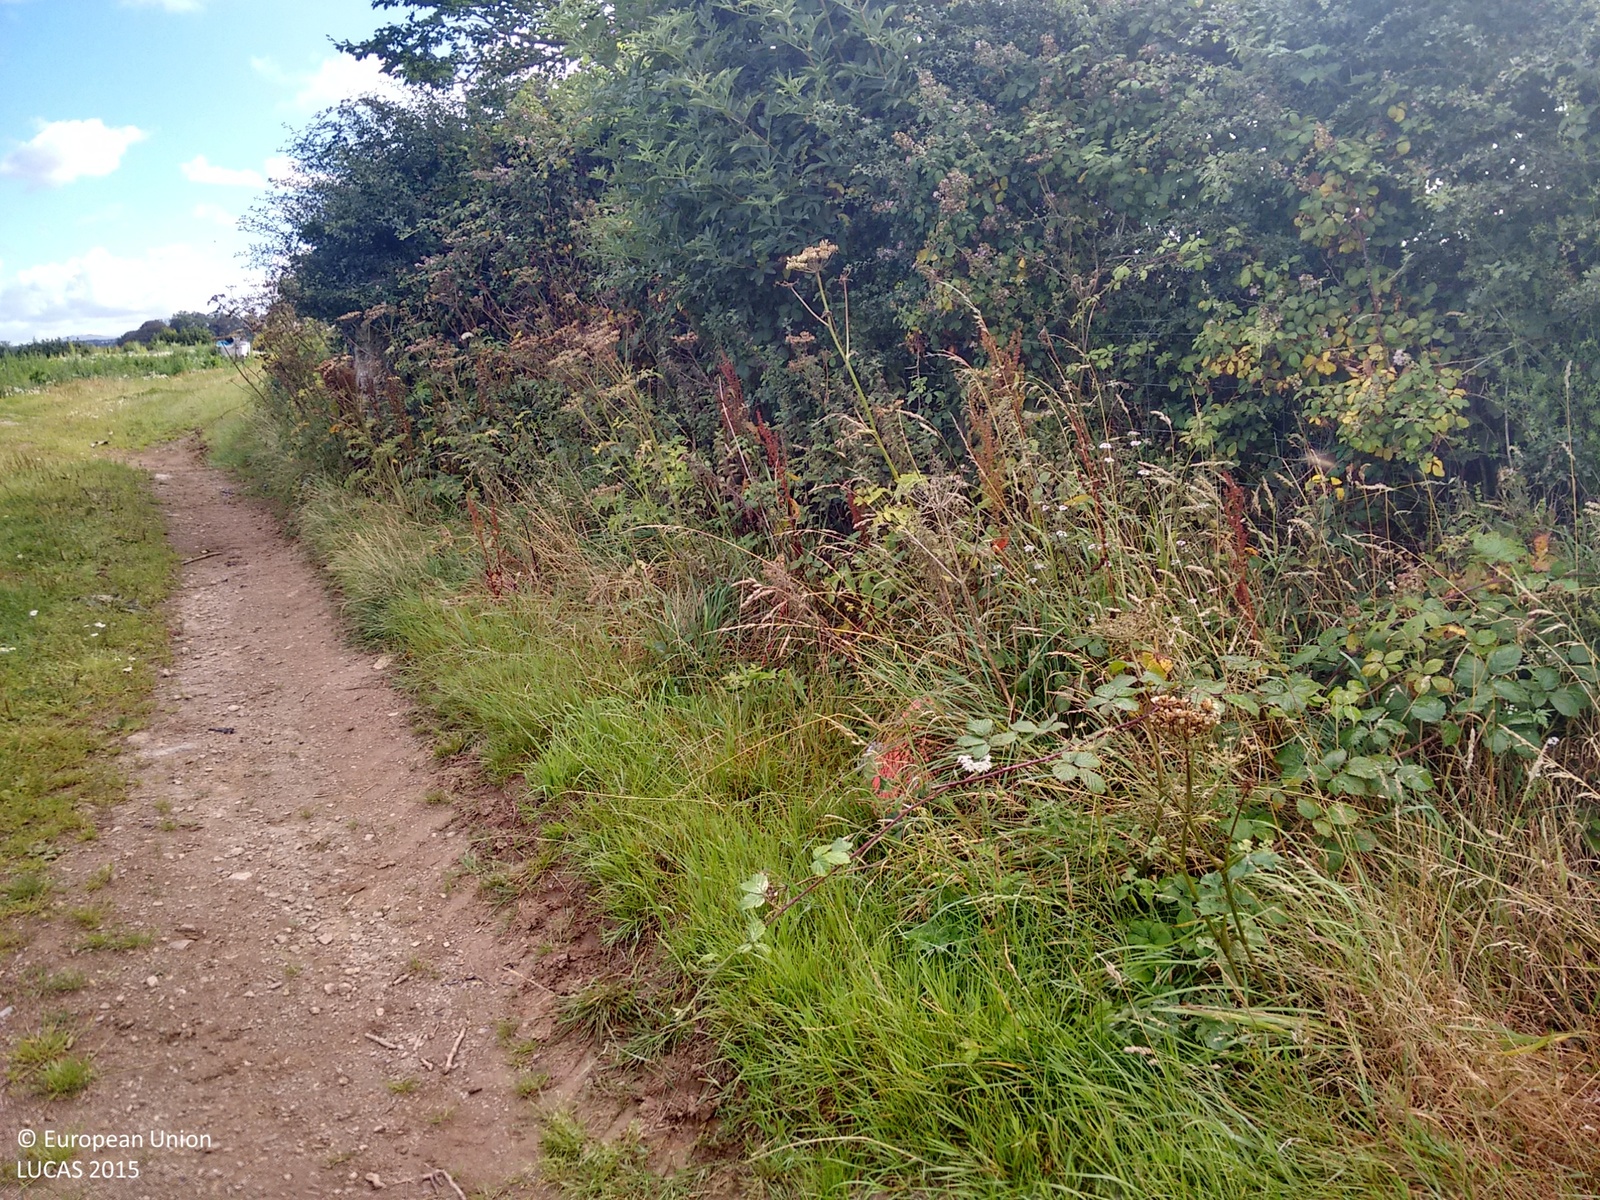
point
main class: Cropland
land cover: Sugar beet
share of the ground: > 75 %
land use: Agriculture (excluding fallow land and kitchen gardens)
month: August
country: GB
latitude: 50.4657
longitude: -4.1424
